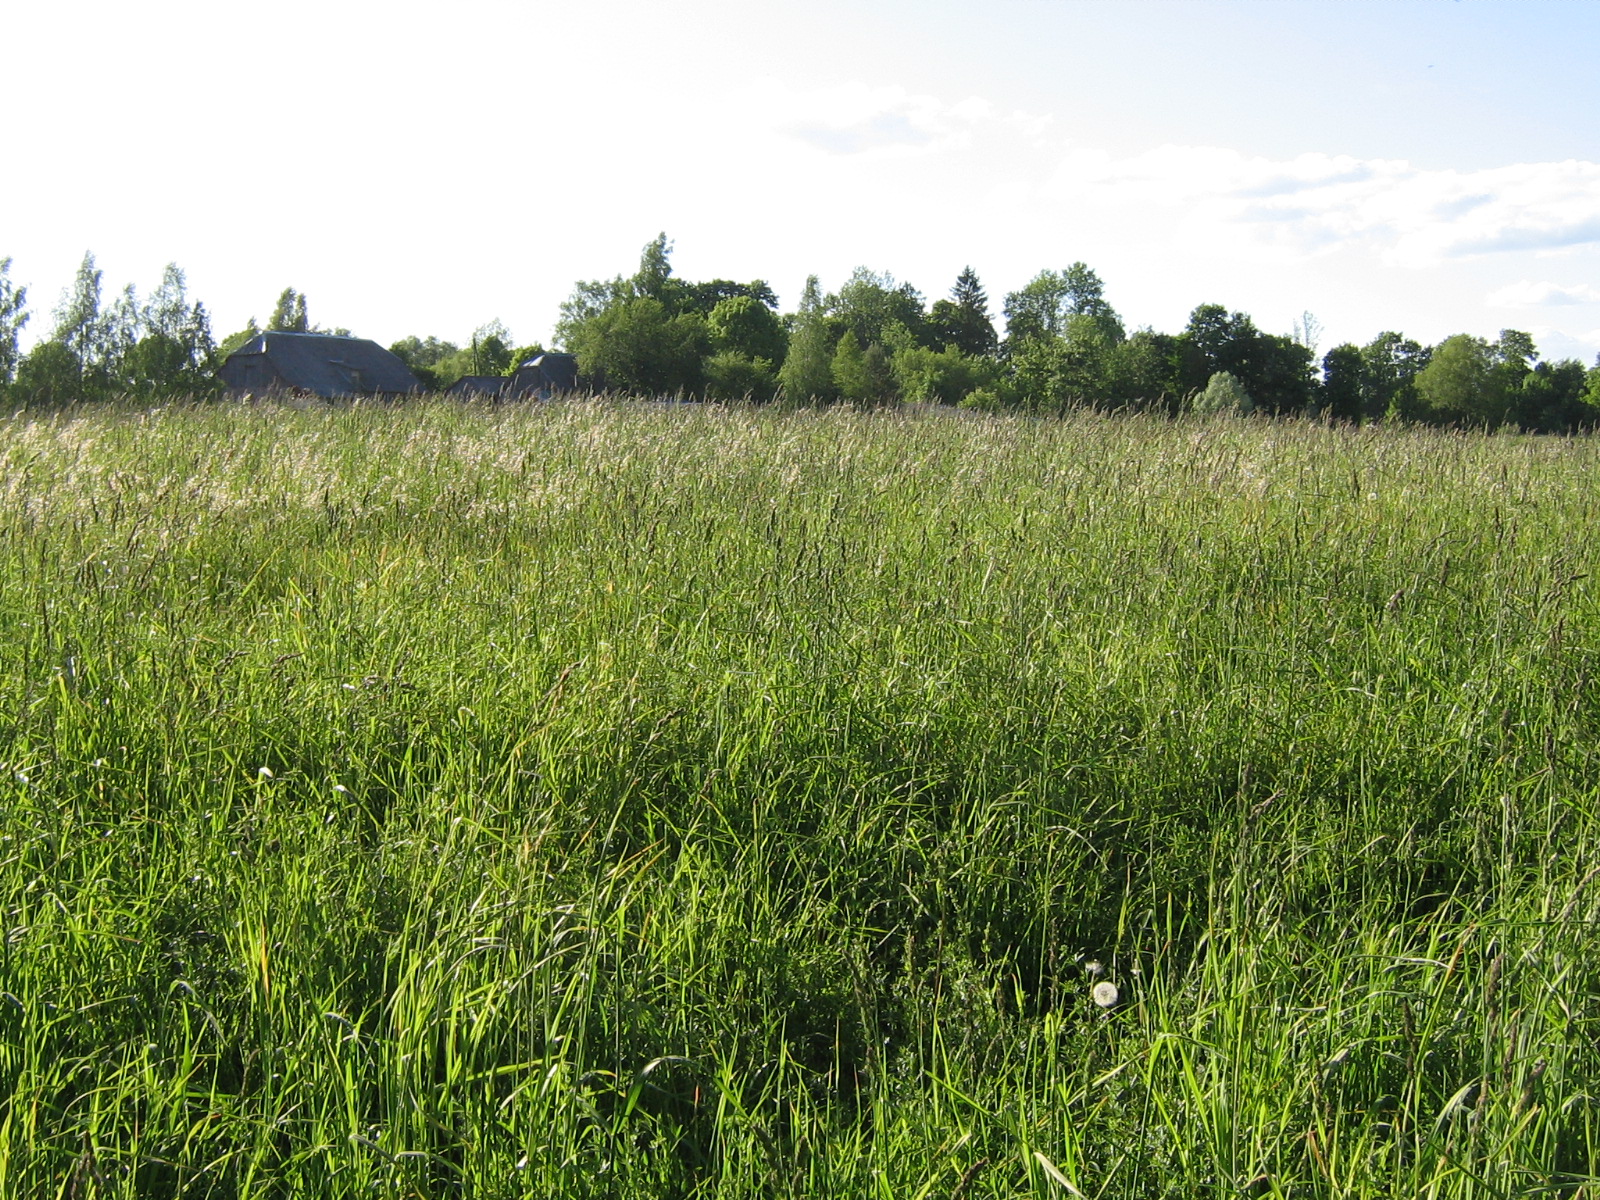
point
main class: Grassland
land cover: Grassland without tree/shrub cover
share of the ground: > 75 %
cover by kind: herbaceous plants 100 %
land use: Agriculture (excluding fallow land and kitchen gardens)
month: June
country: LV
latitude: 57.1555
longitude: 25.8818
